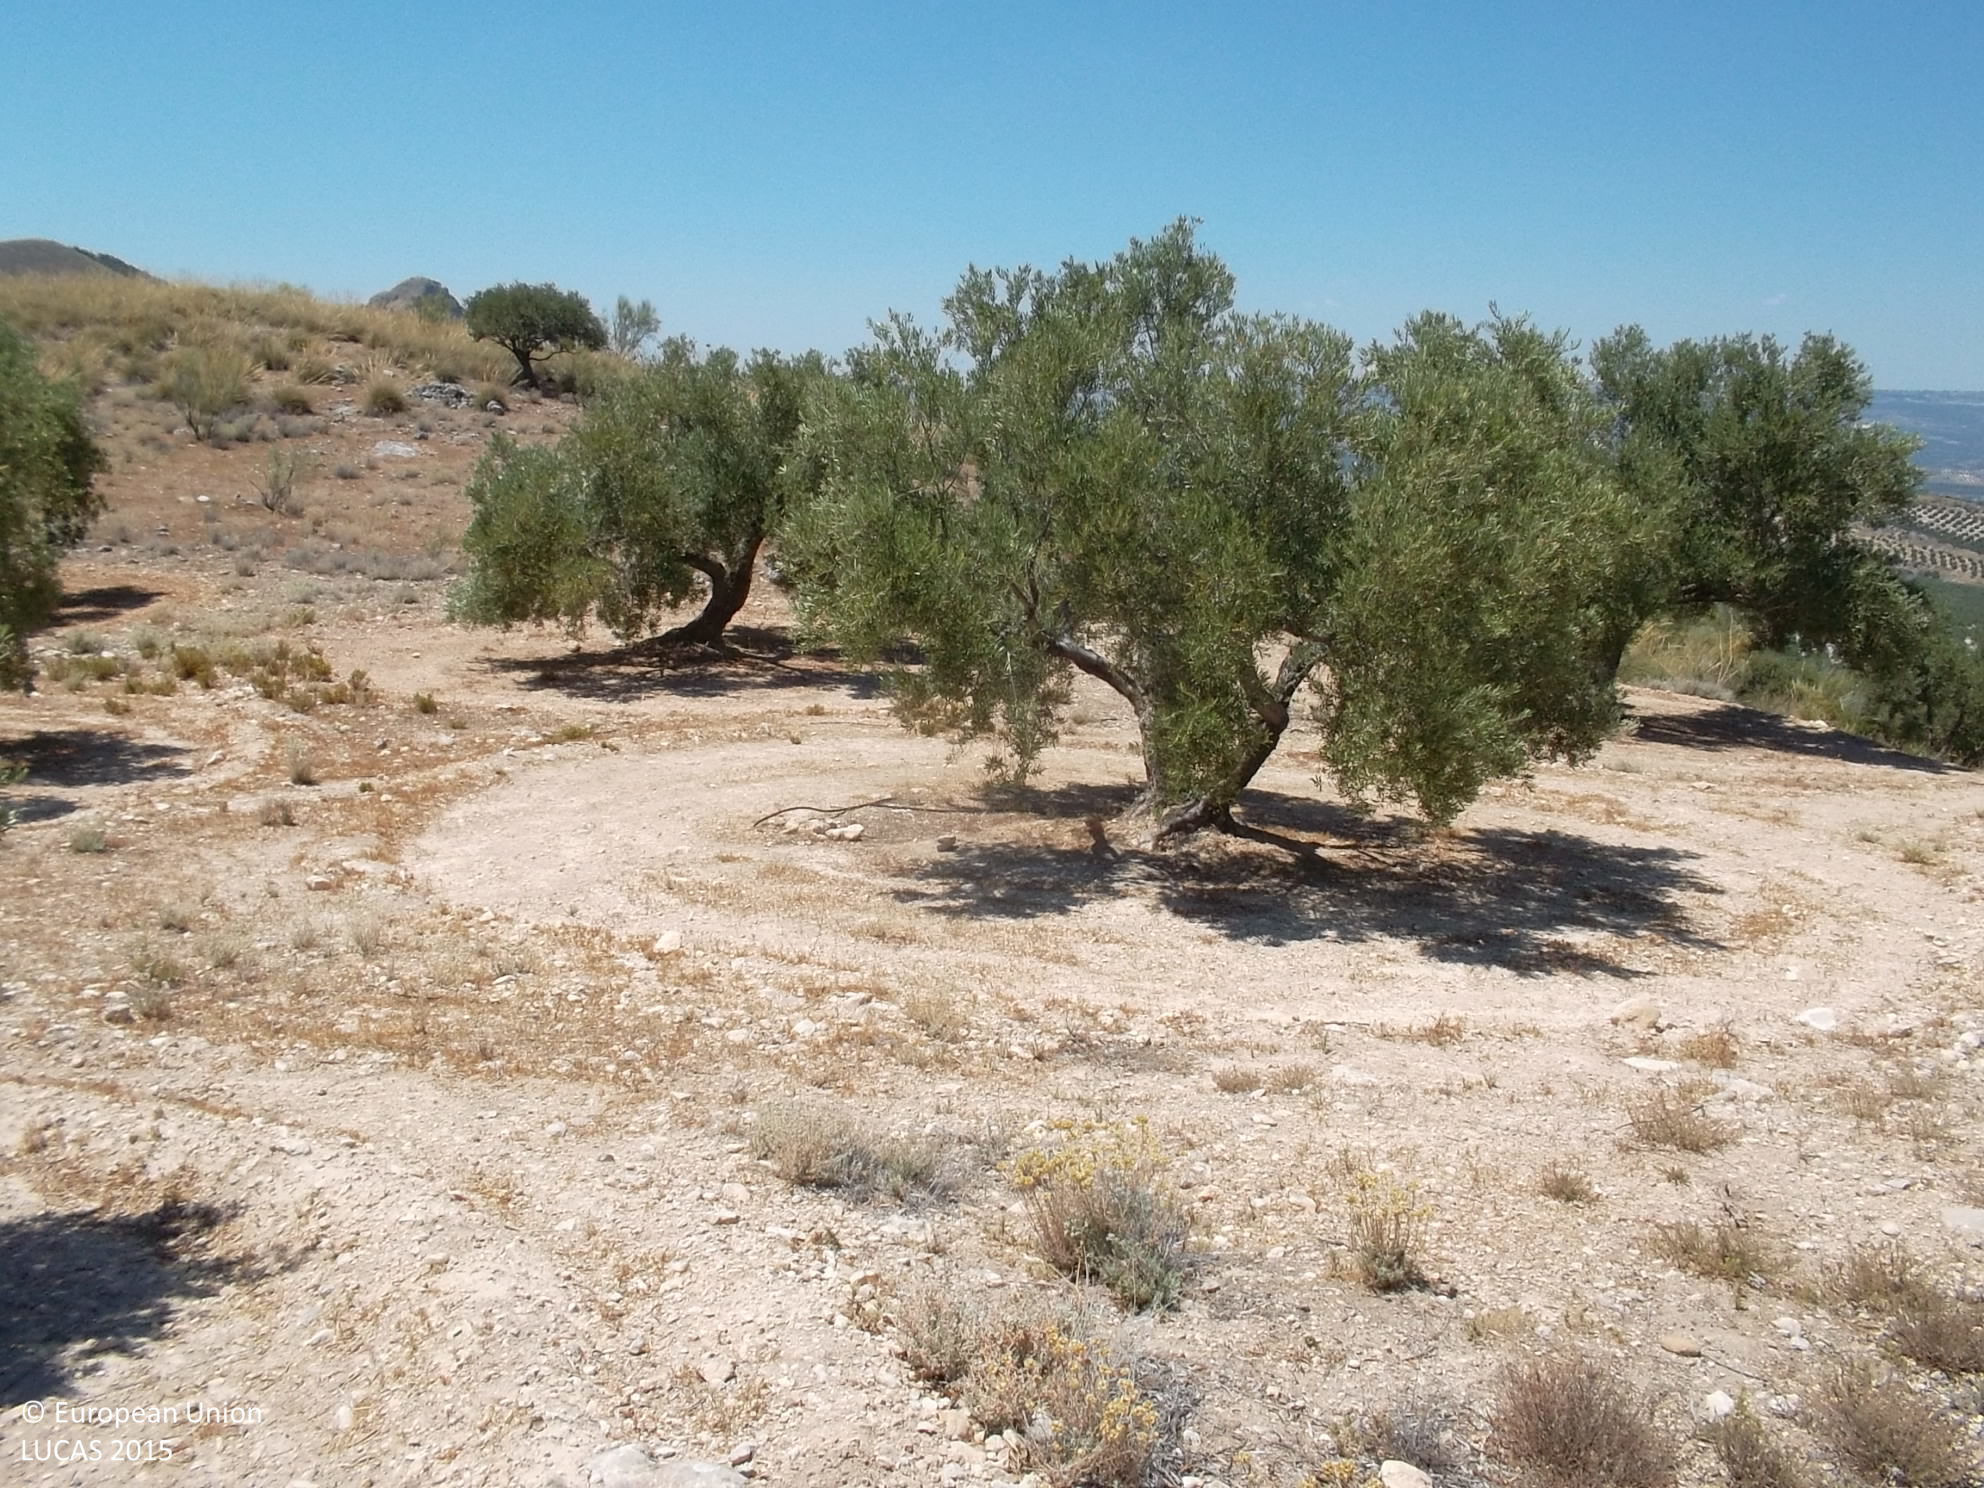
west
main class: Cropland
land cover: Olive groves
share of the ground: 25 - 50 %
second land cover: Other bare soil
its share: > 75 %
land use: Agriculture (excluding fallow land and kitchen gardens)
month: June
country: ES
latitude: 37.8590
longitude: -3.3988
